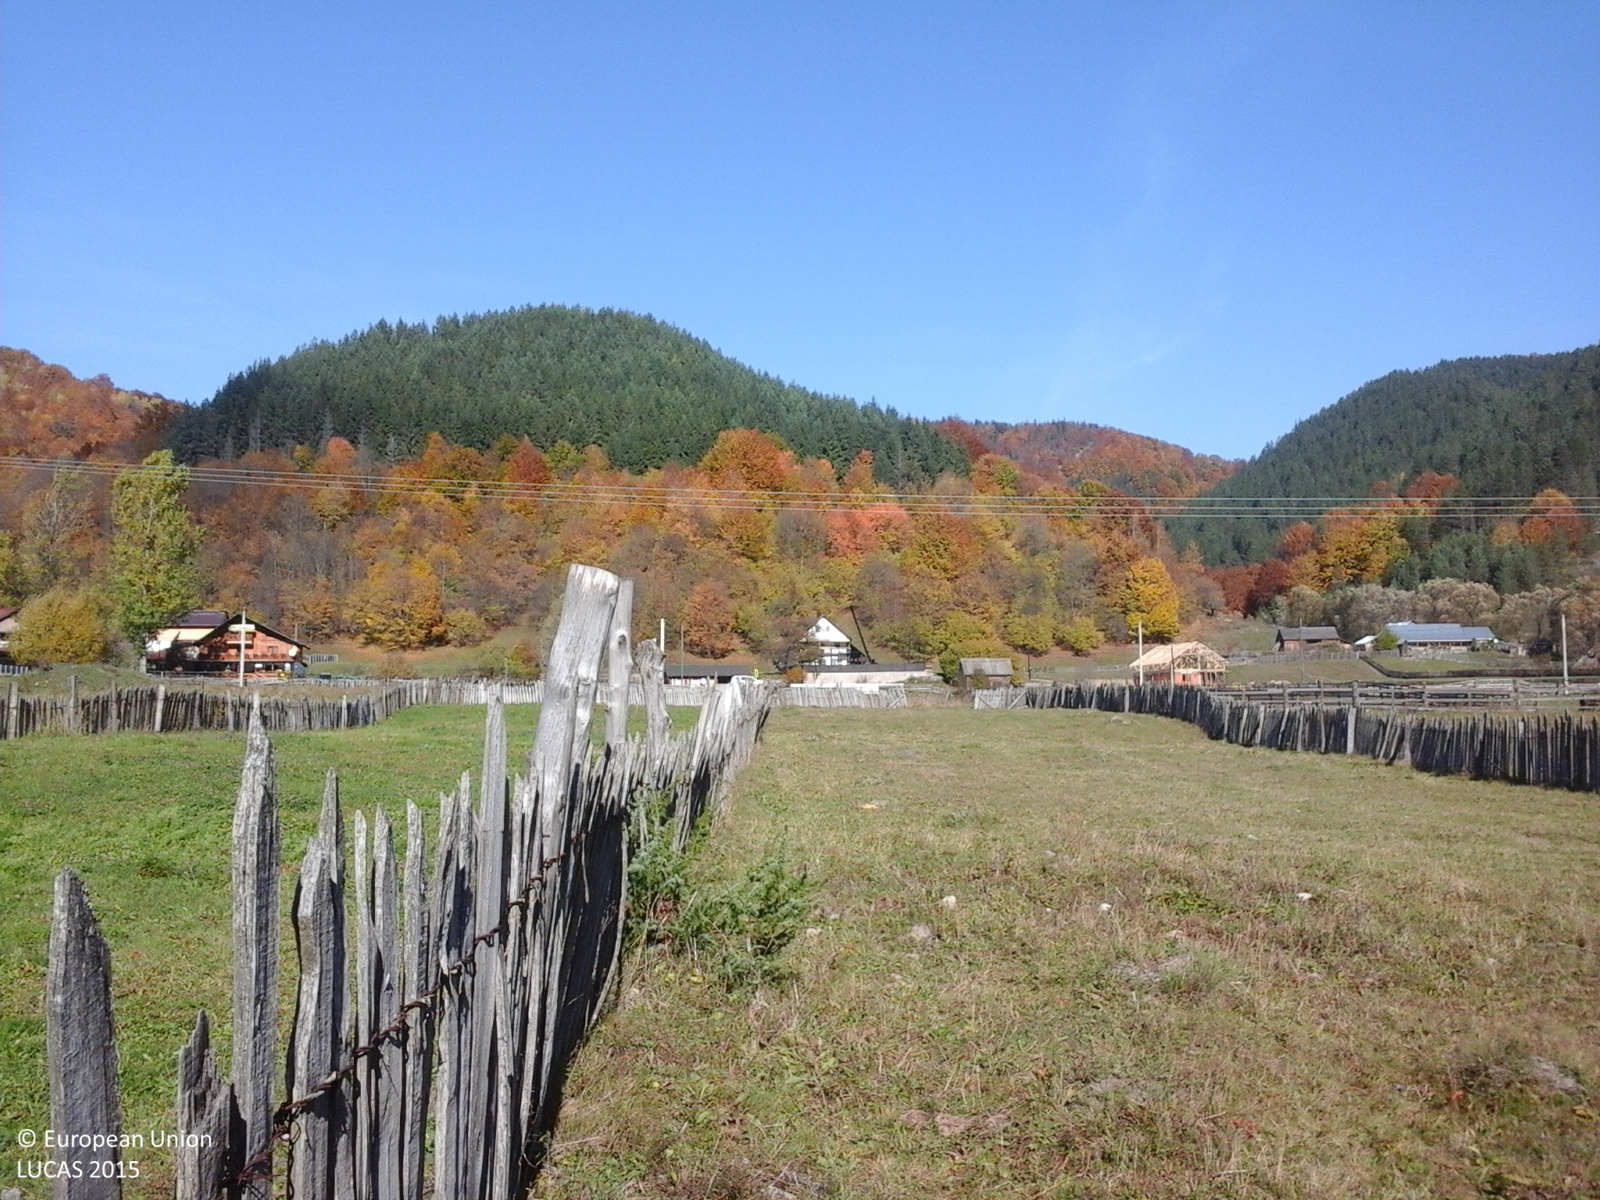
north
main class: Grassland
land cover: Grassland without tree/shrub cover
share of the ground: > 75 %
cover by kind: herbaceous plants 100 %
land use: Agriculture (excluding fallow land and kitchen gardens)
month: October
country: RO
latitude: 45.9501
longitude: 26.5537
